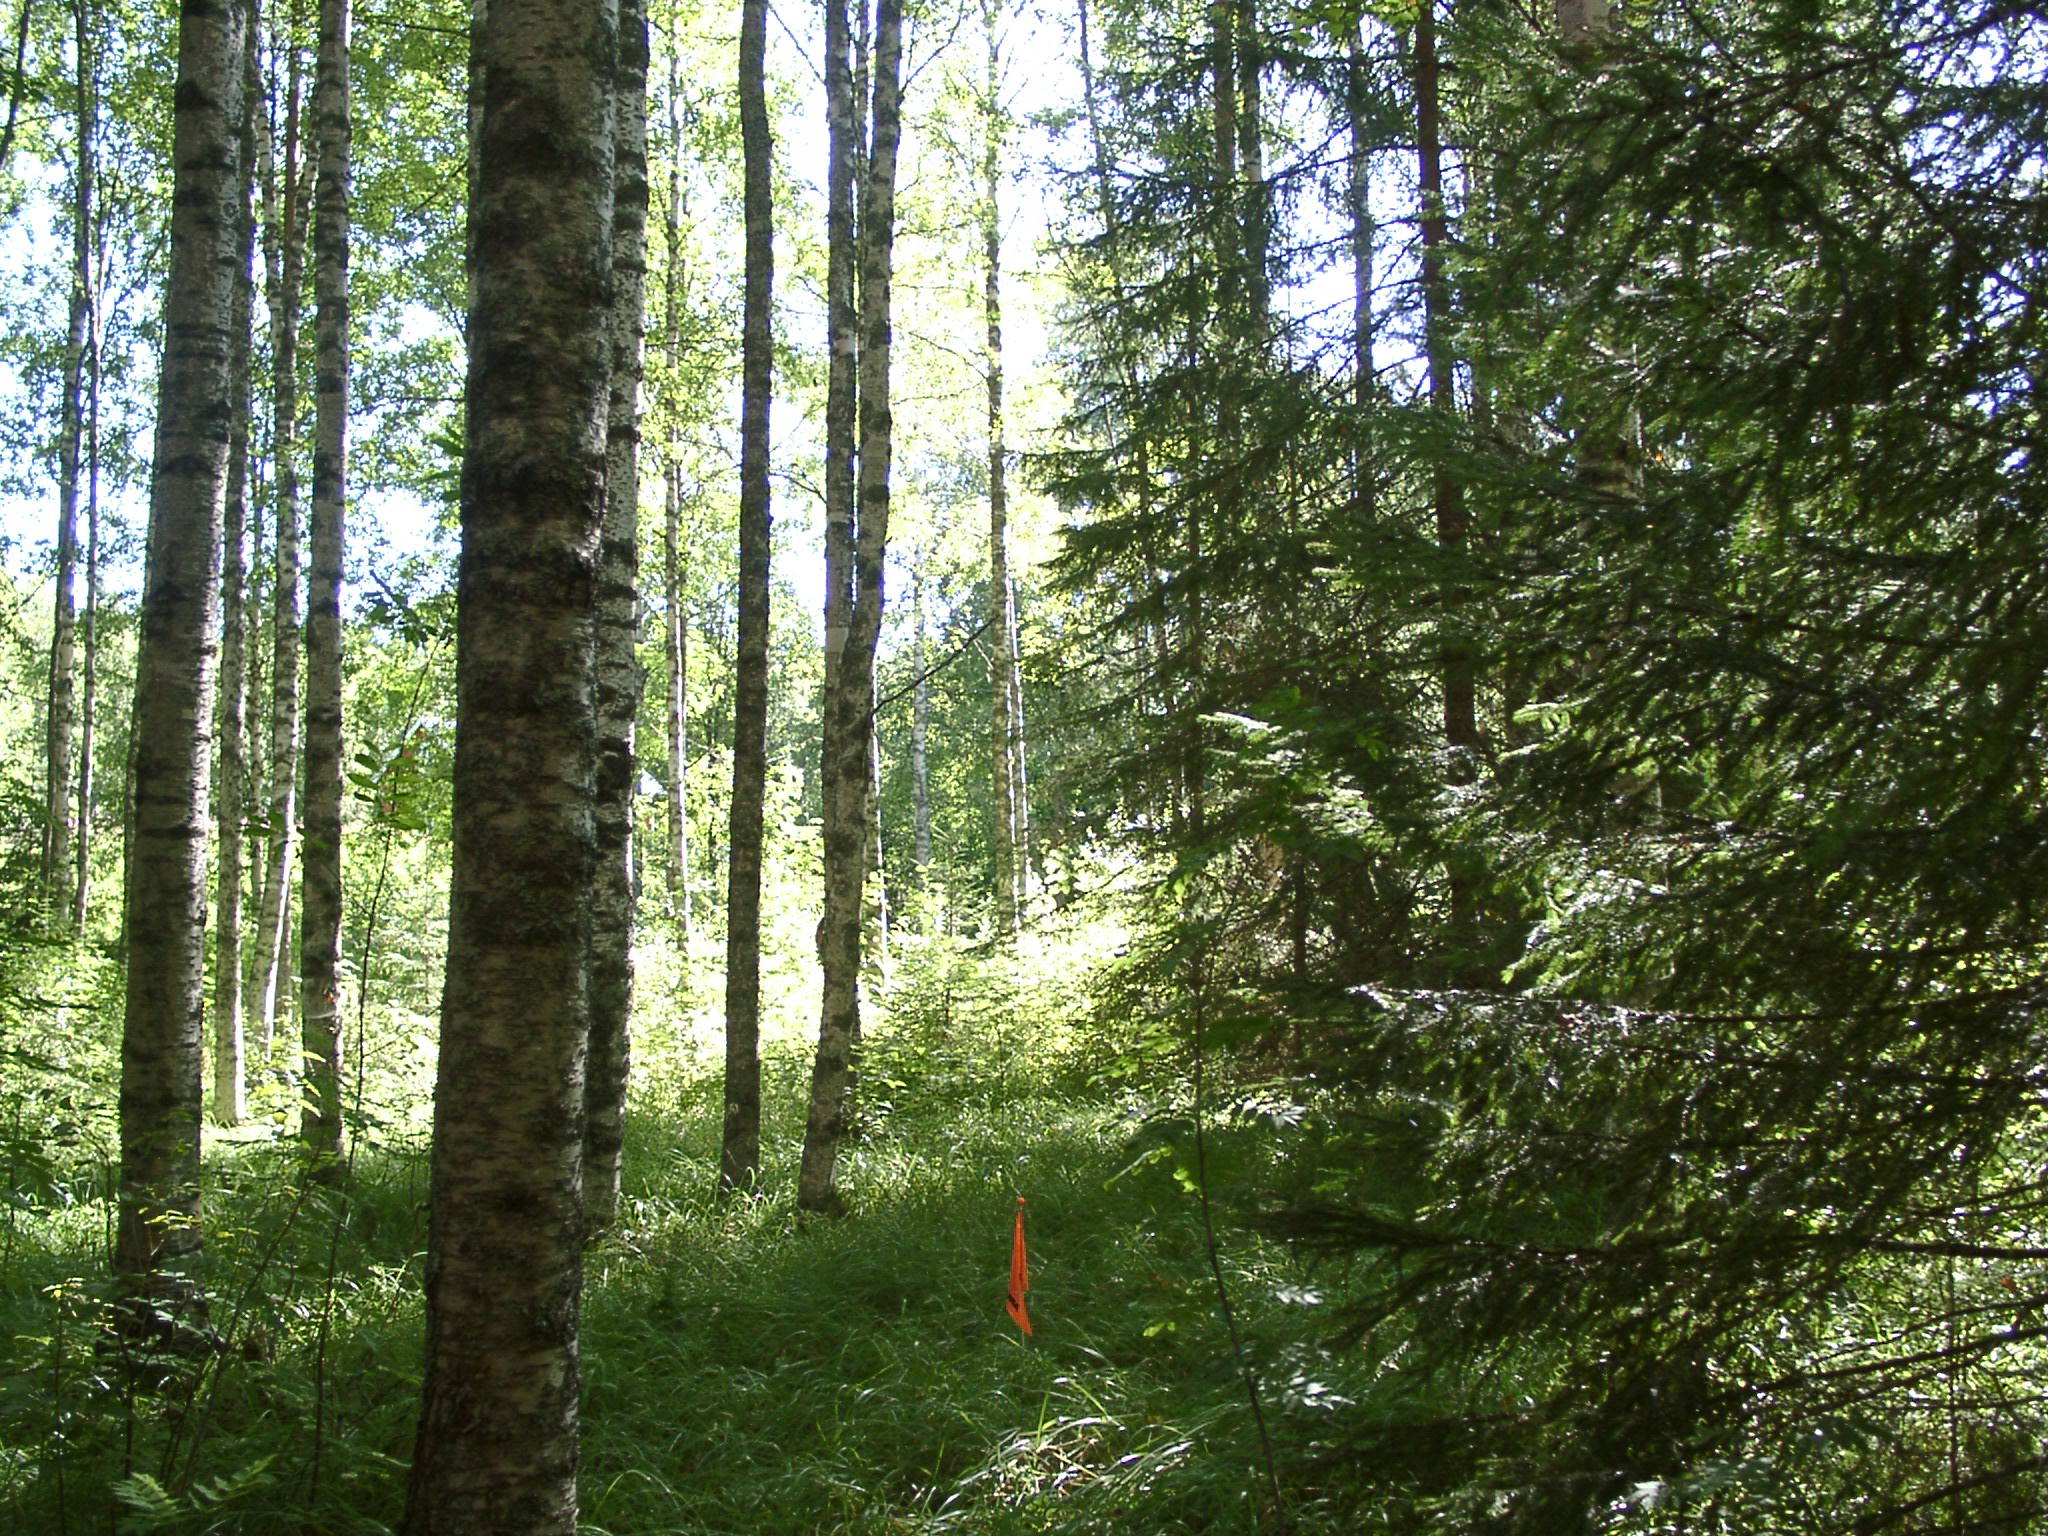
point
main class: Woodland
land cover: Spruce dominated mixed woodland
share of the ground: 50 - 75 %
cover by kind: broadleaved forest trees 50 %, herbaceous plants 25 %, coniferous forest trees 20 %, lichens and mosses 5 %
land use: Forestry
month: August
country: FI
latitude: 62.4034
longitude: 25.2185
